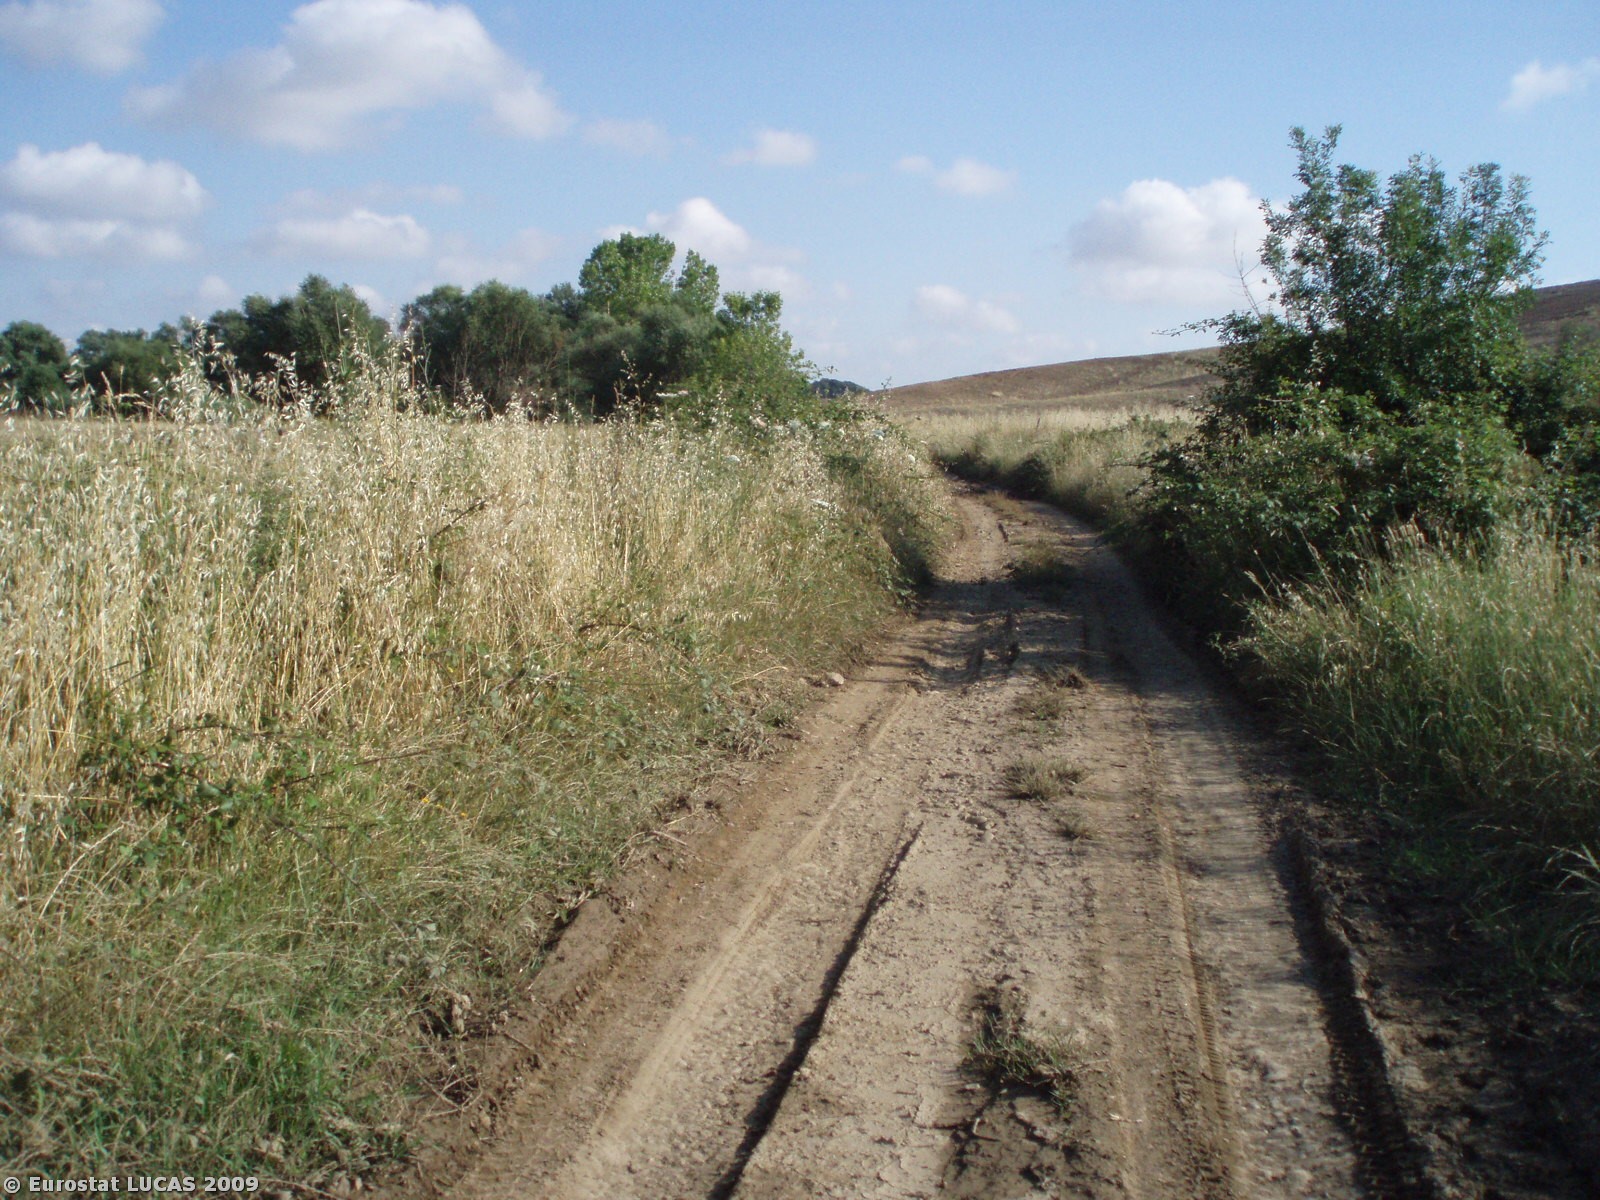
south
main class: Cropland
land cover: Temporary grasslands
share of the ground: > 75 %
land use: Agriculture (excluding fallow land and kitchen gardens)
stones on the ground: < 10 %
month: June
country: IT
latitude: 42.4605
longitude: 11.6118
